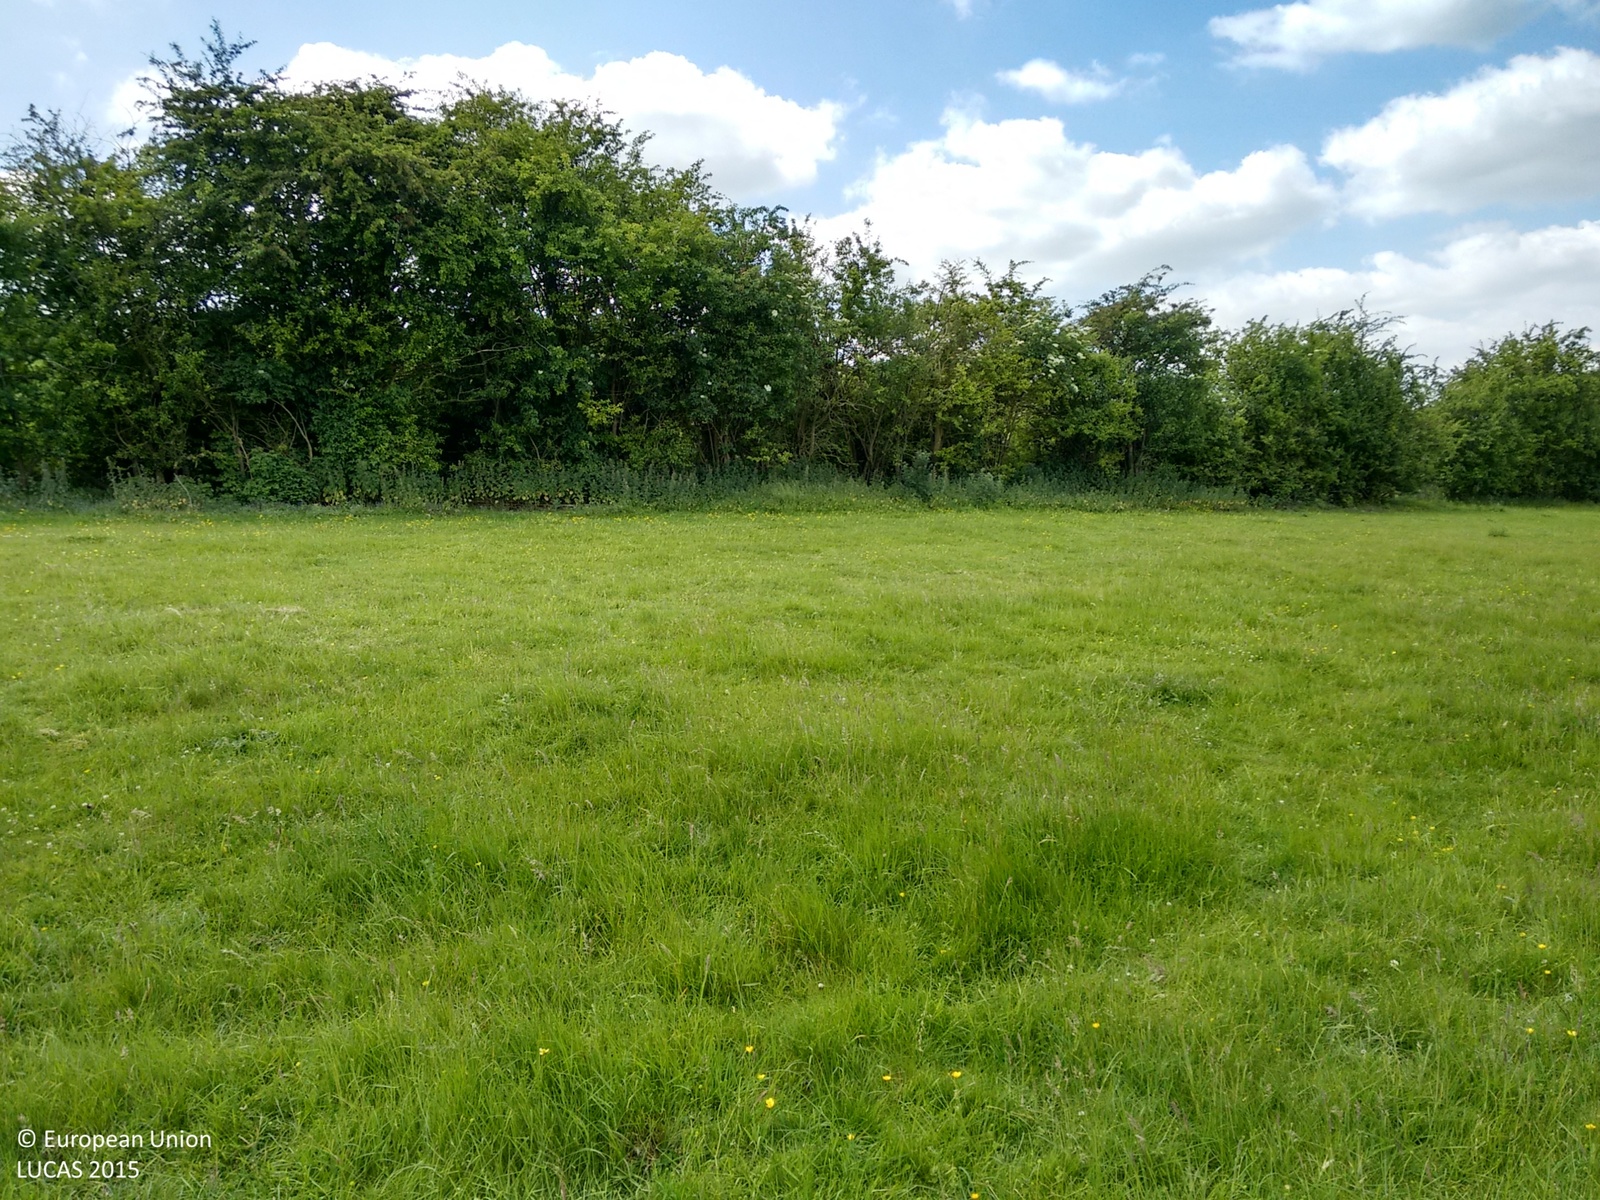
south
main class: Grassland
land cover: Grassland without tree/shrub cover
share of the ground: > 75 %
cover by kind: herbaceous plants 100 %
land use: Agriculture (excluding fallow land and kitchen gardens)
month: June
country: GB
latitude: 51.4128
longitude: -1.5398
